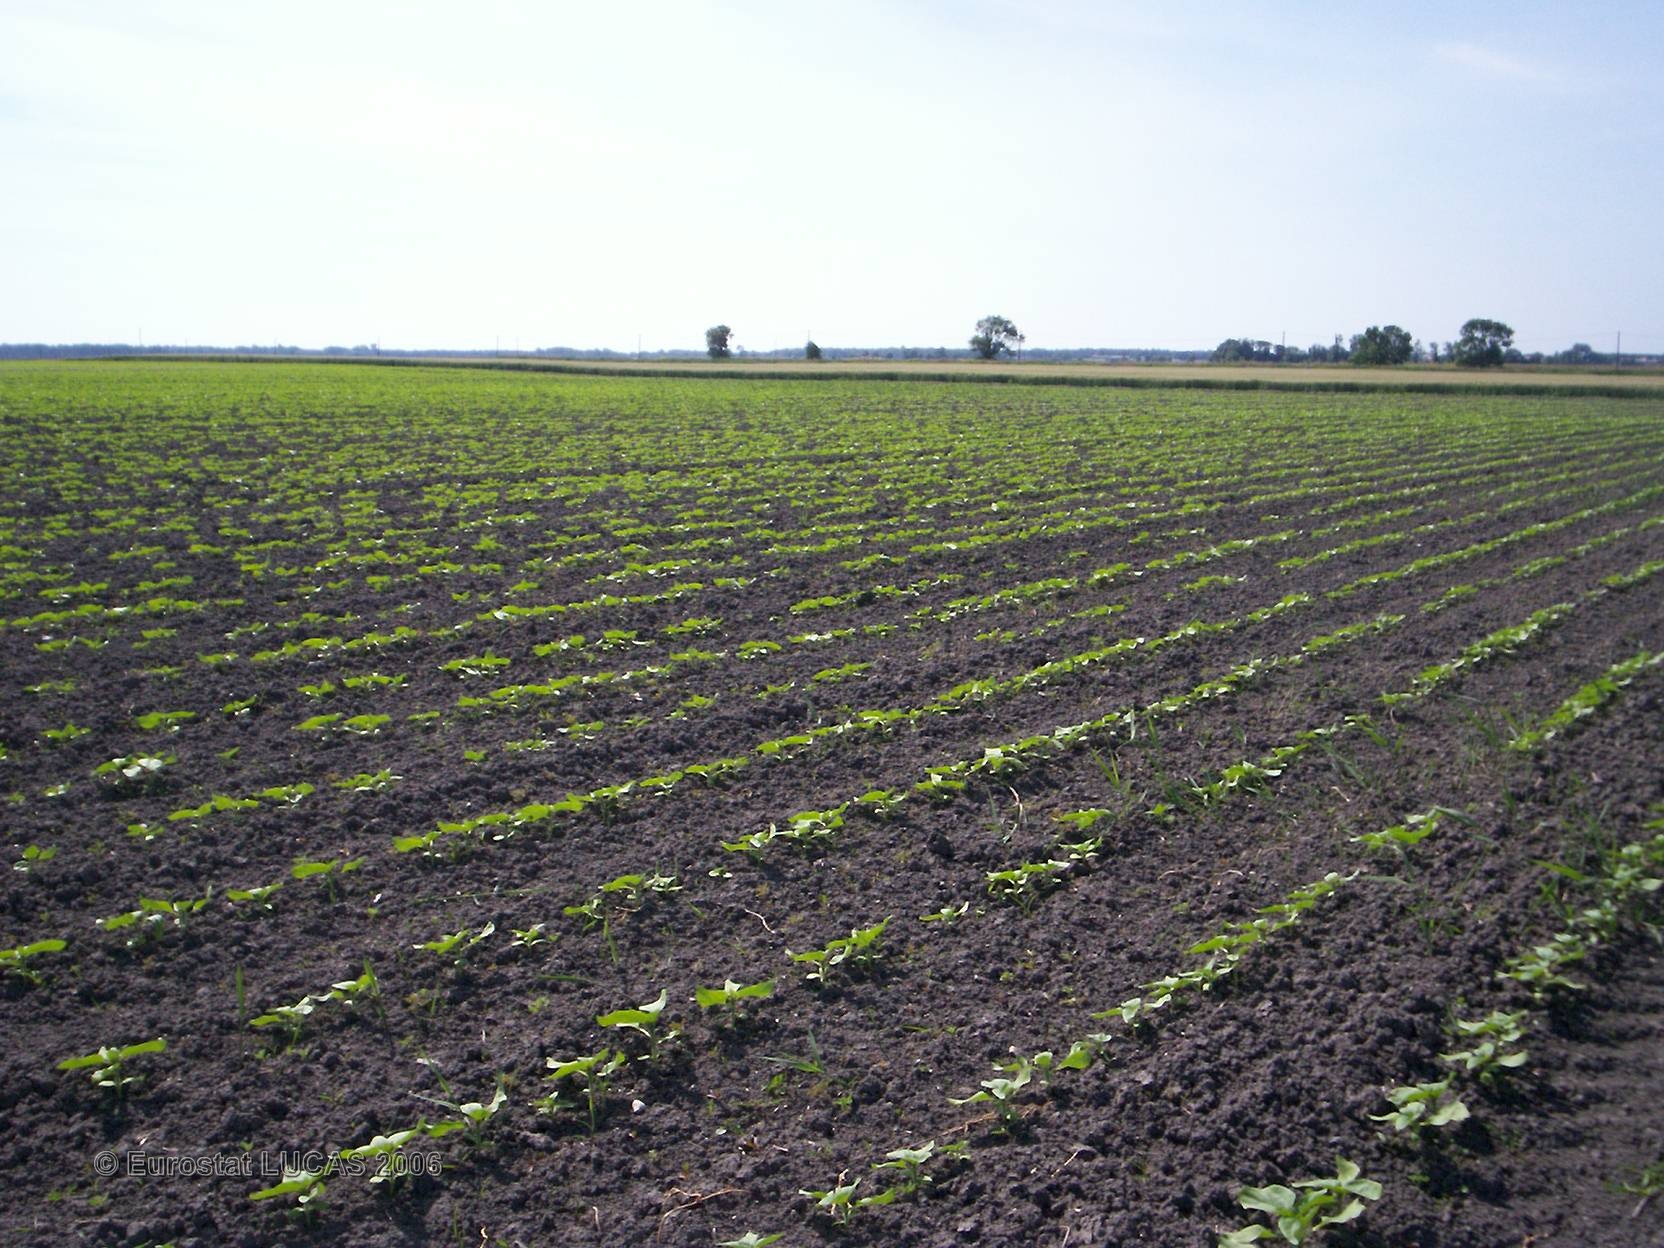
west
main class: Cropland
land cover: Sunflower
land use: Agriculture (excluding fallow land and kitchen gardens)
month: June
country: FR
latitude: 45.7003
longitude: -1.0867
